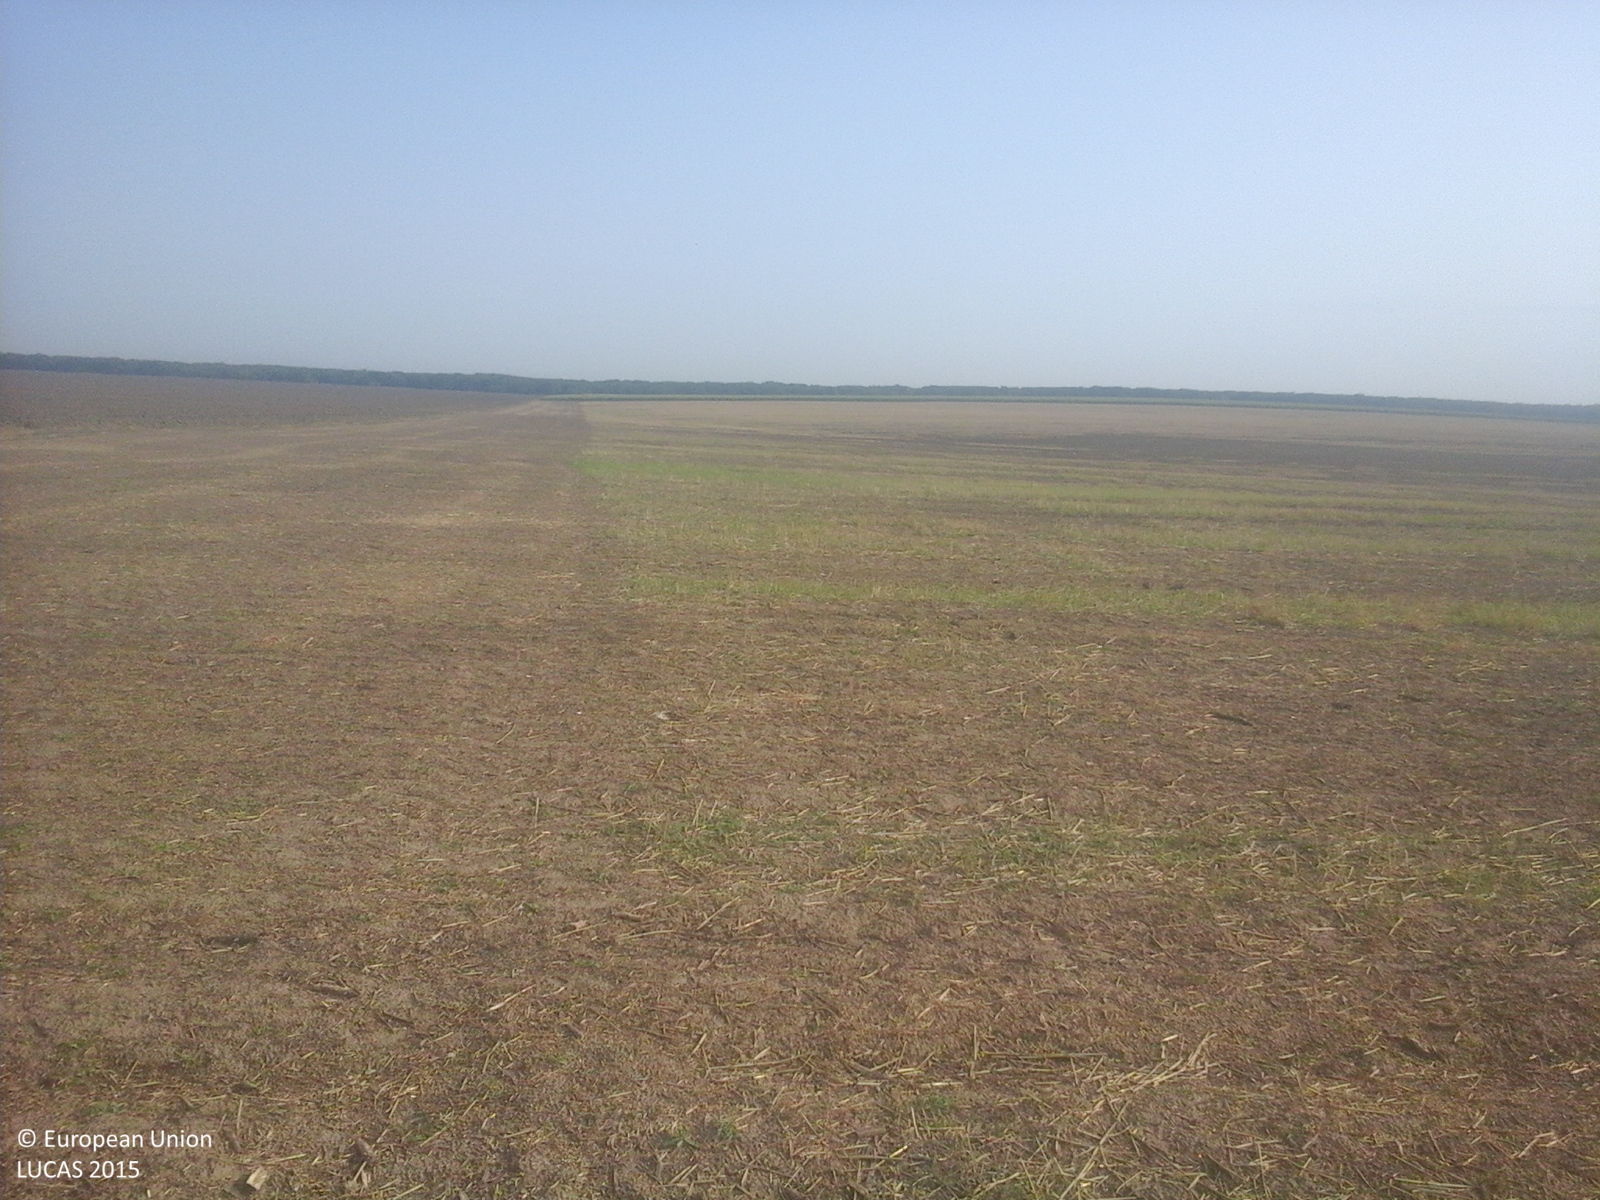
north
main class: Cropland
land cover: Common wheat
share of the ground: < 10 %
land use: Agriculture (excluding fallow land and kitchen gardens)
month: August
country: RO
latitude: 43.9928
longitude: 28.2269
